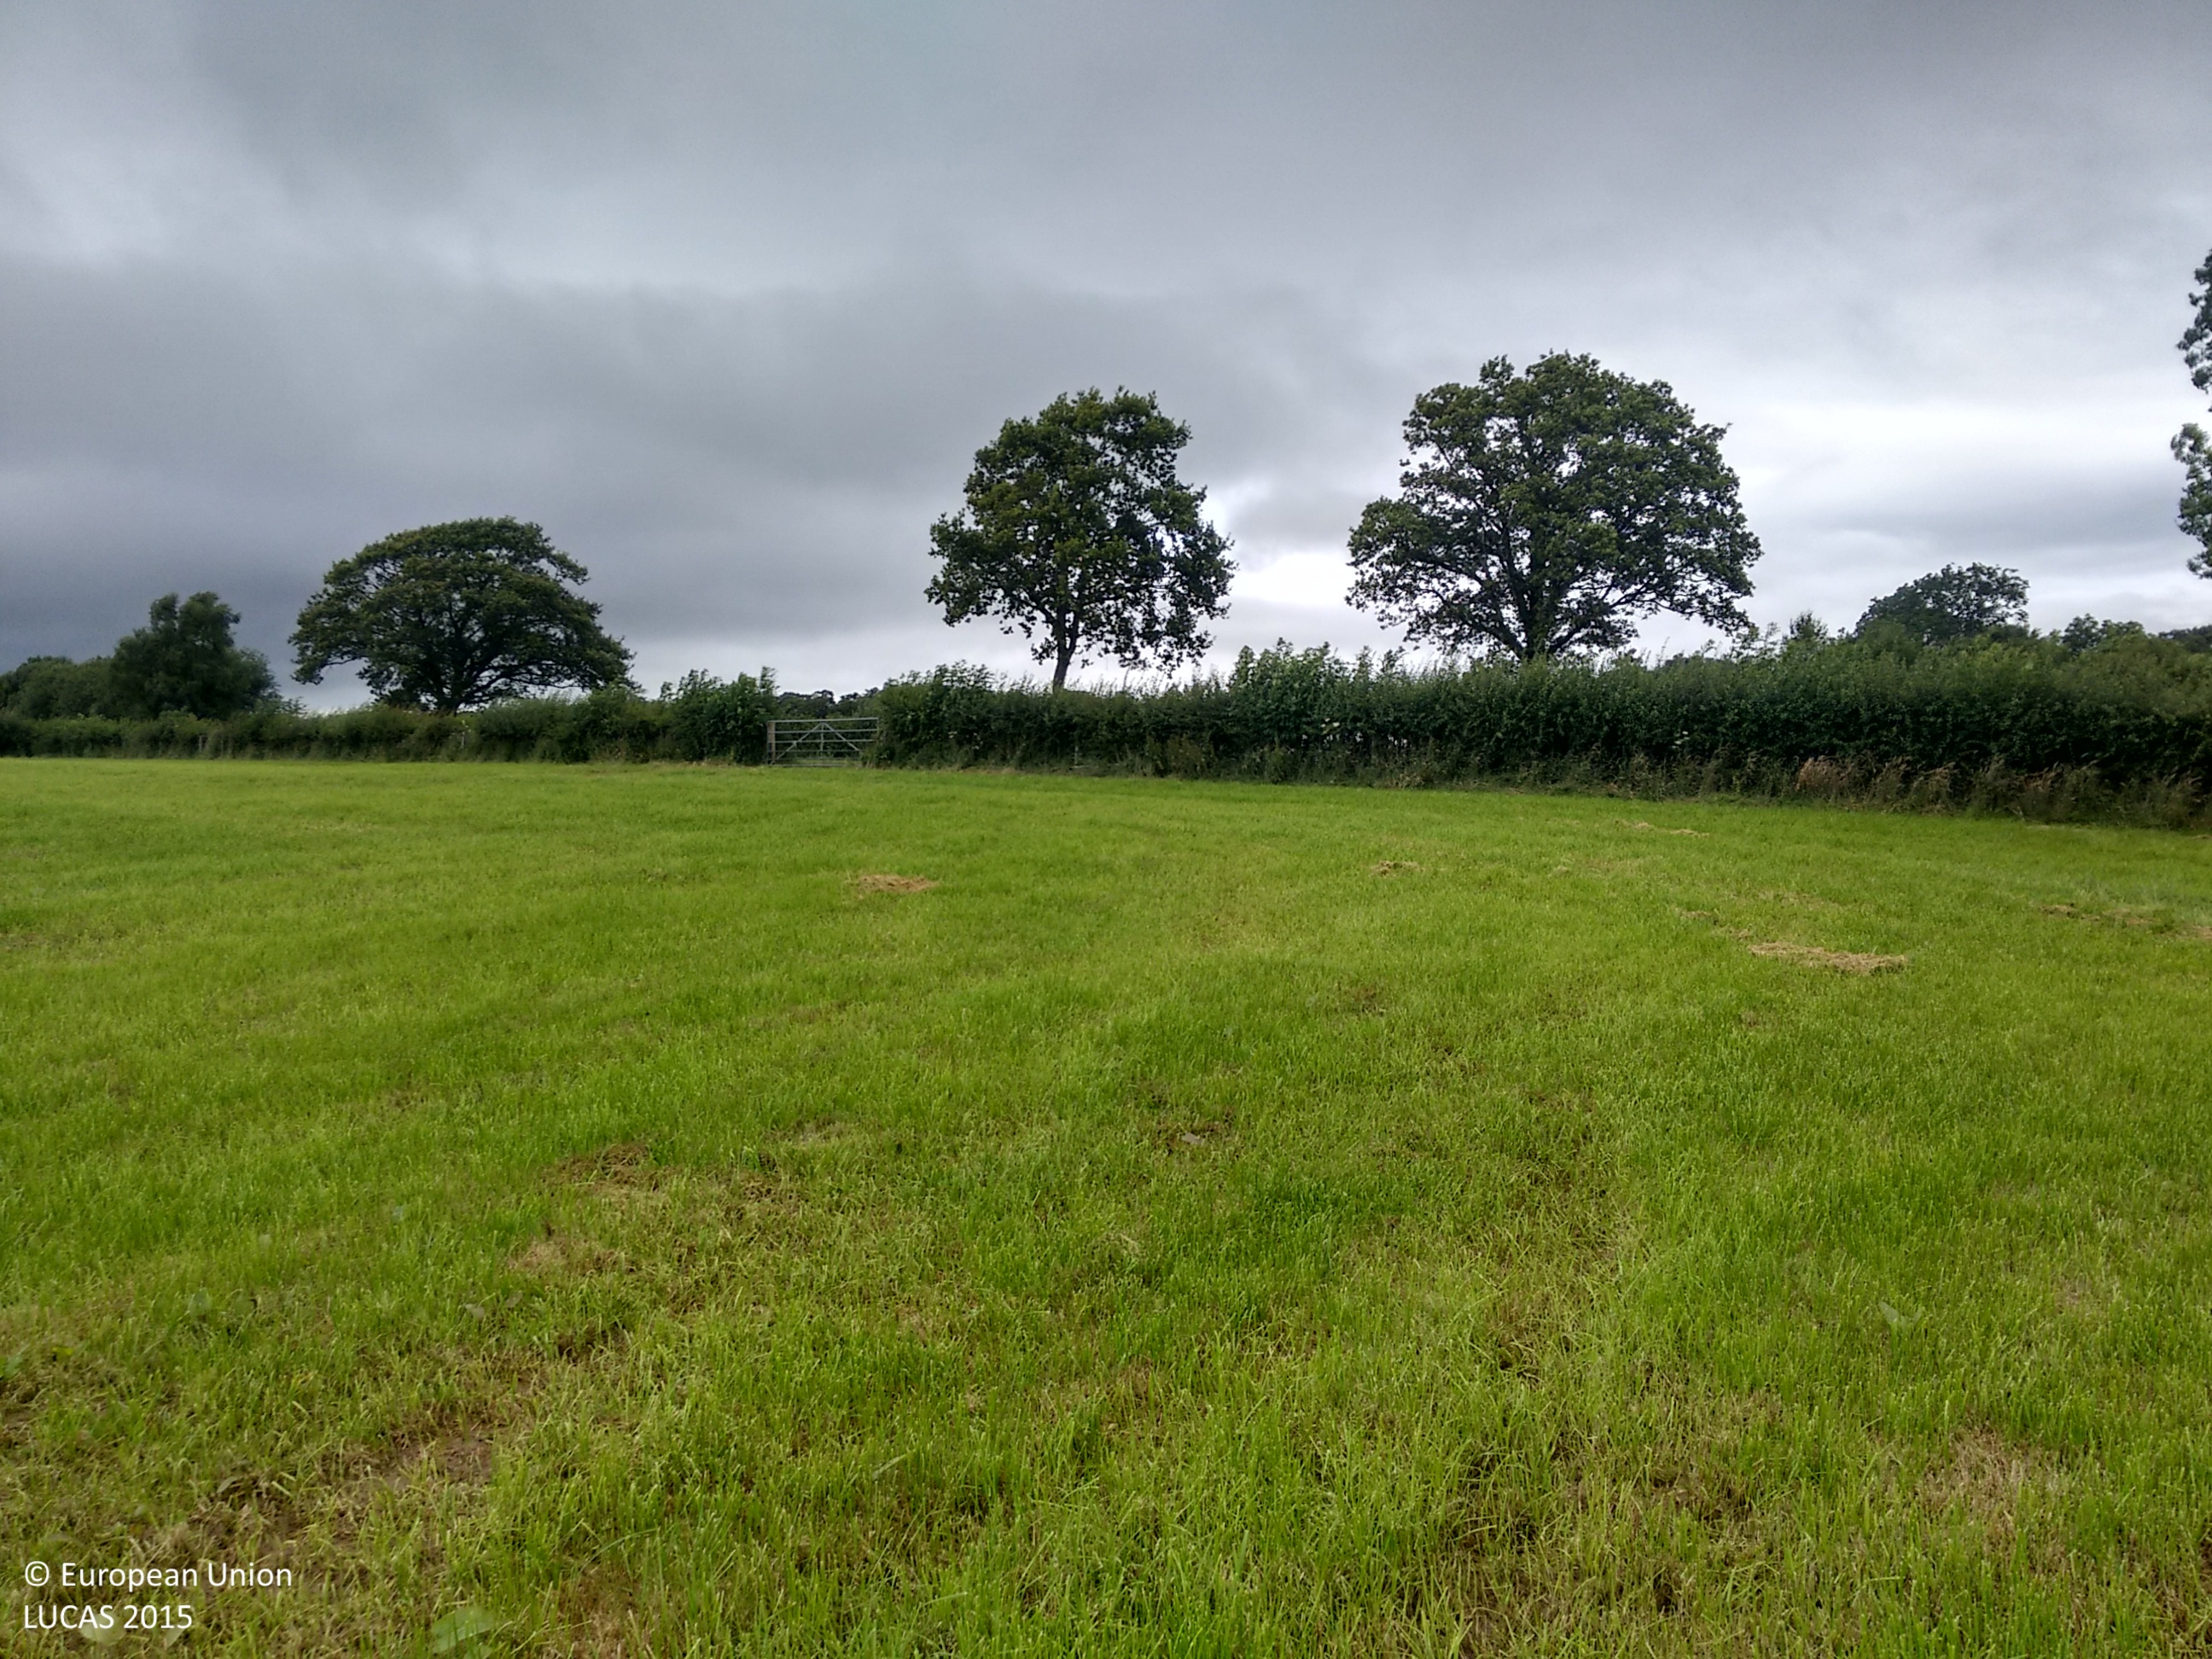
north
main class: Grassland
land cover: Grassland without tree/shrub cover
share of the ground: > 75 %
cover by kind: herbaceous plants 100 %
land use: Agriculture (excluding fallow land and kitchen gardens)
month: August
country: GB
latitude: 54.7617
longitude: -2.9545
